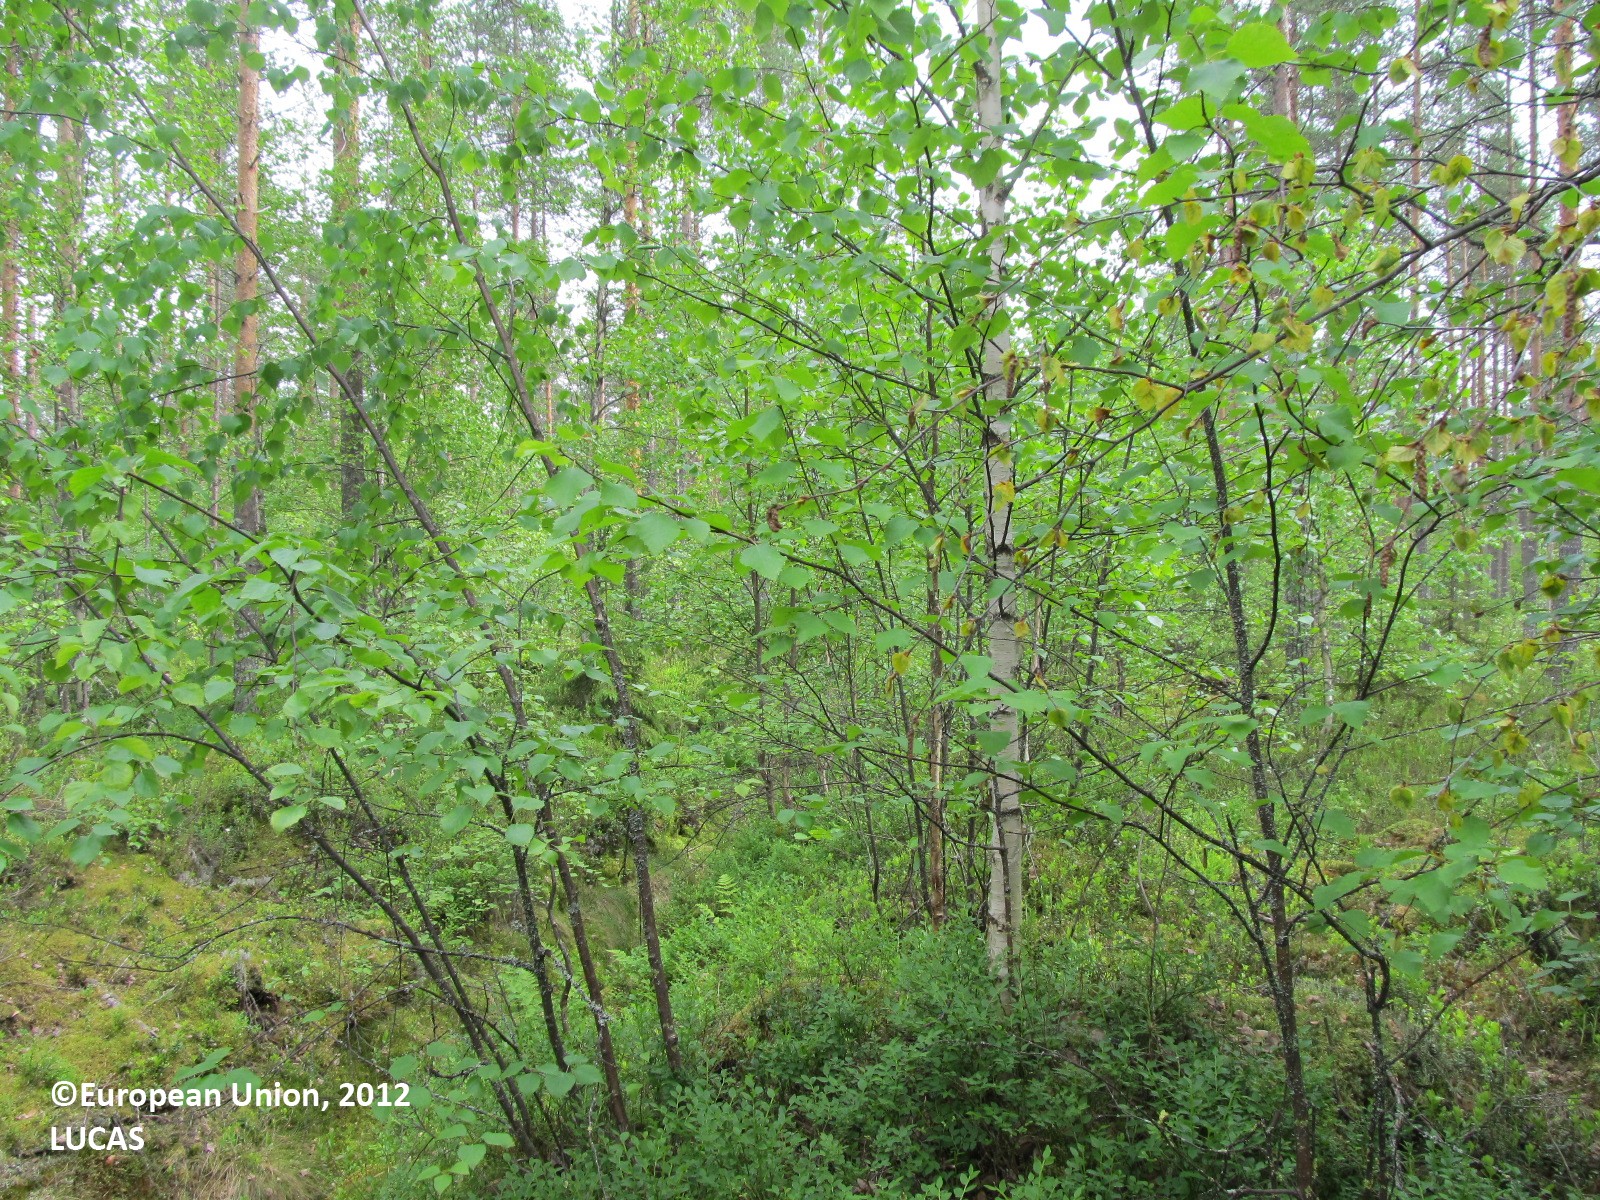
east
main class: Woodland
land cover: Pine dominated mixed woodland
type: boreal forest
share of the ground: 50 - 75 %
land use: Forestry
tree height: > 5 m
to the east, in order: Pine dominated mixed woodland; Ditches and canals; Pine dominated coniferous woodland; Ditches and canals; Pine dominated coniferous woodland; Ditches and canals; Pine dominated coniferous woodland; Ditches and canals; Pine dominated coniferous woodland; Pine dominated mixed woodland; Ditches and canals; Pine dominated mixed woodland; Spruce dominated coniferous woodland; Ditches and canals; Spruce dominated coniferous woodland
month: June
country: FI
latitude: 62.8211
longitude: 28.9958
